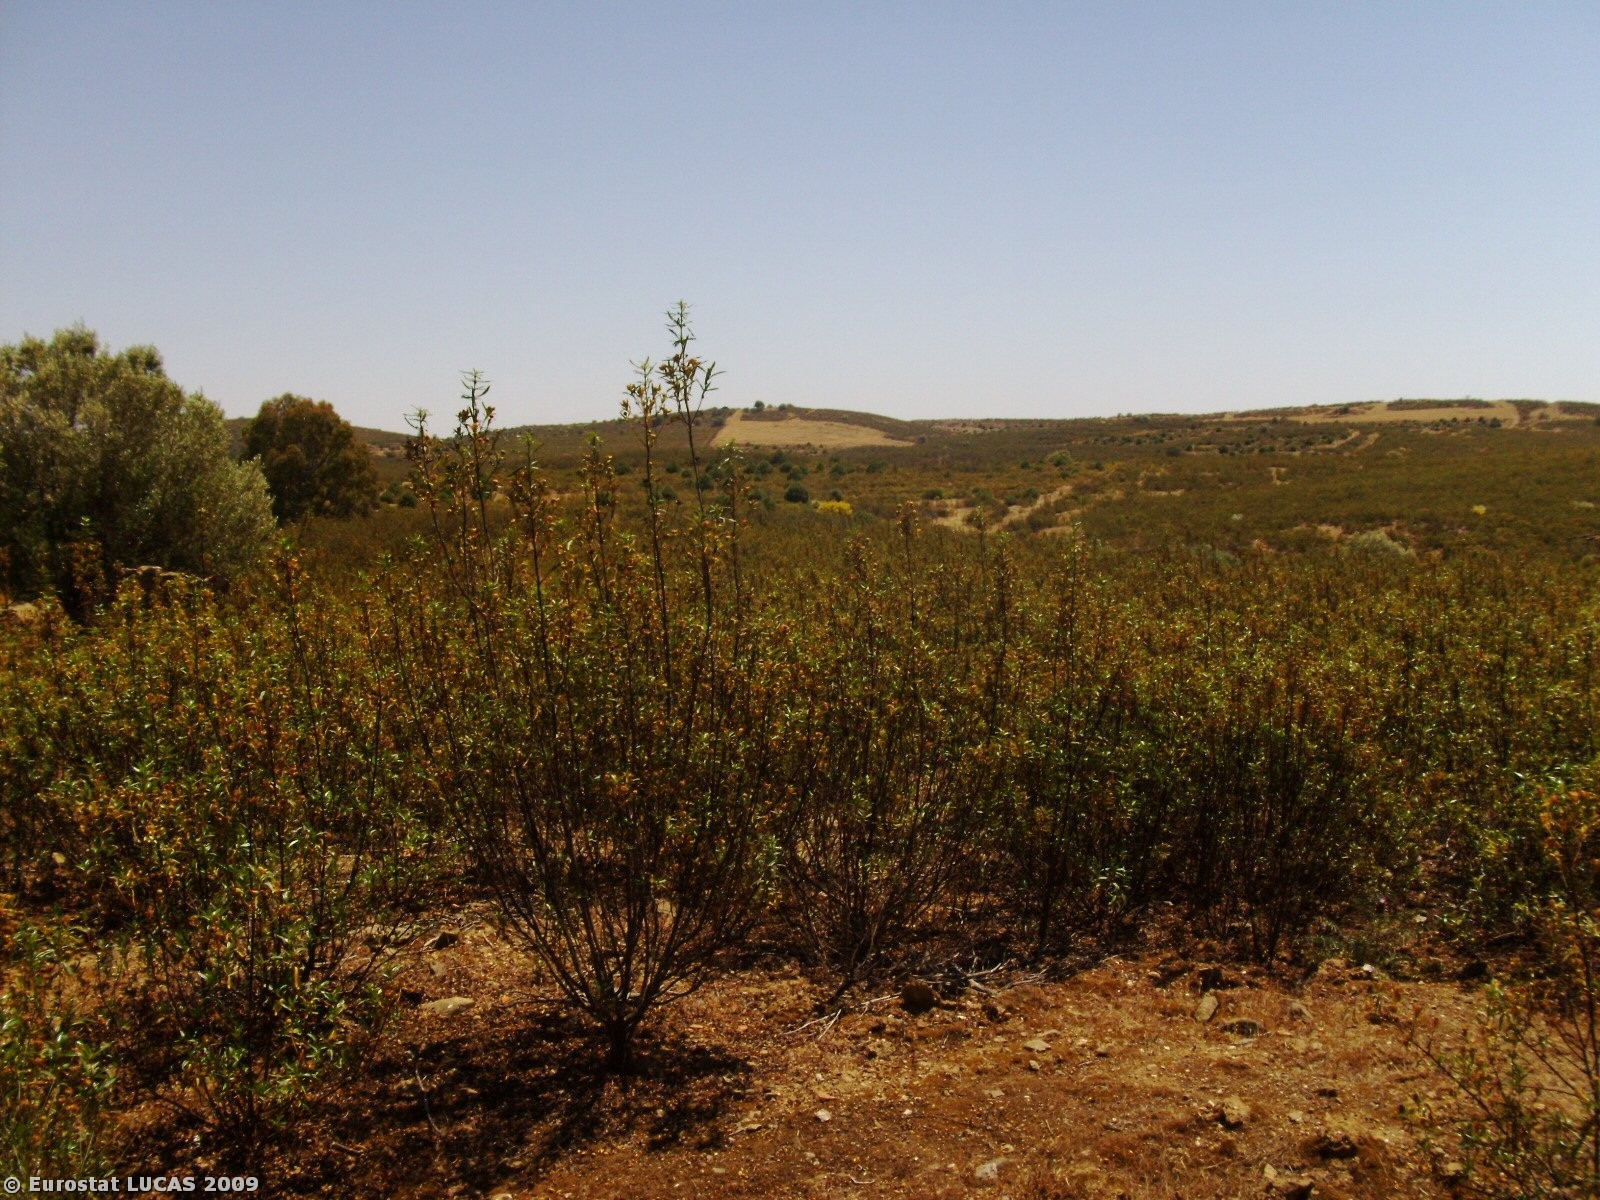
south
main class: Shrubland
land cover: Shrubland without tree cover
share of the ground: 25 - 50 %
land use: Nature reserves
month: May
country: PT
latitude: 37.6221
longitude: -7.7255
